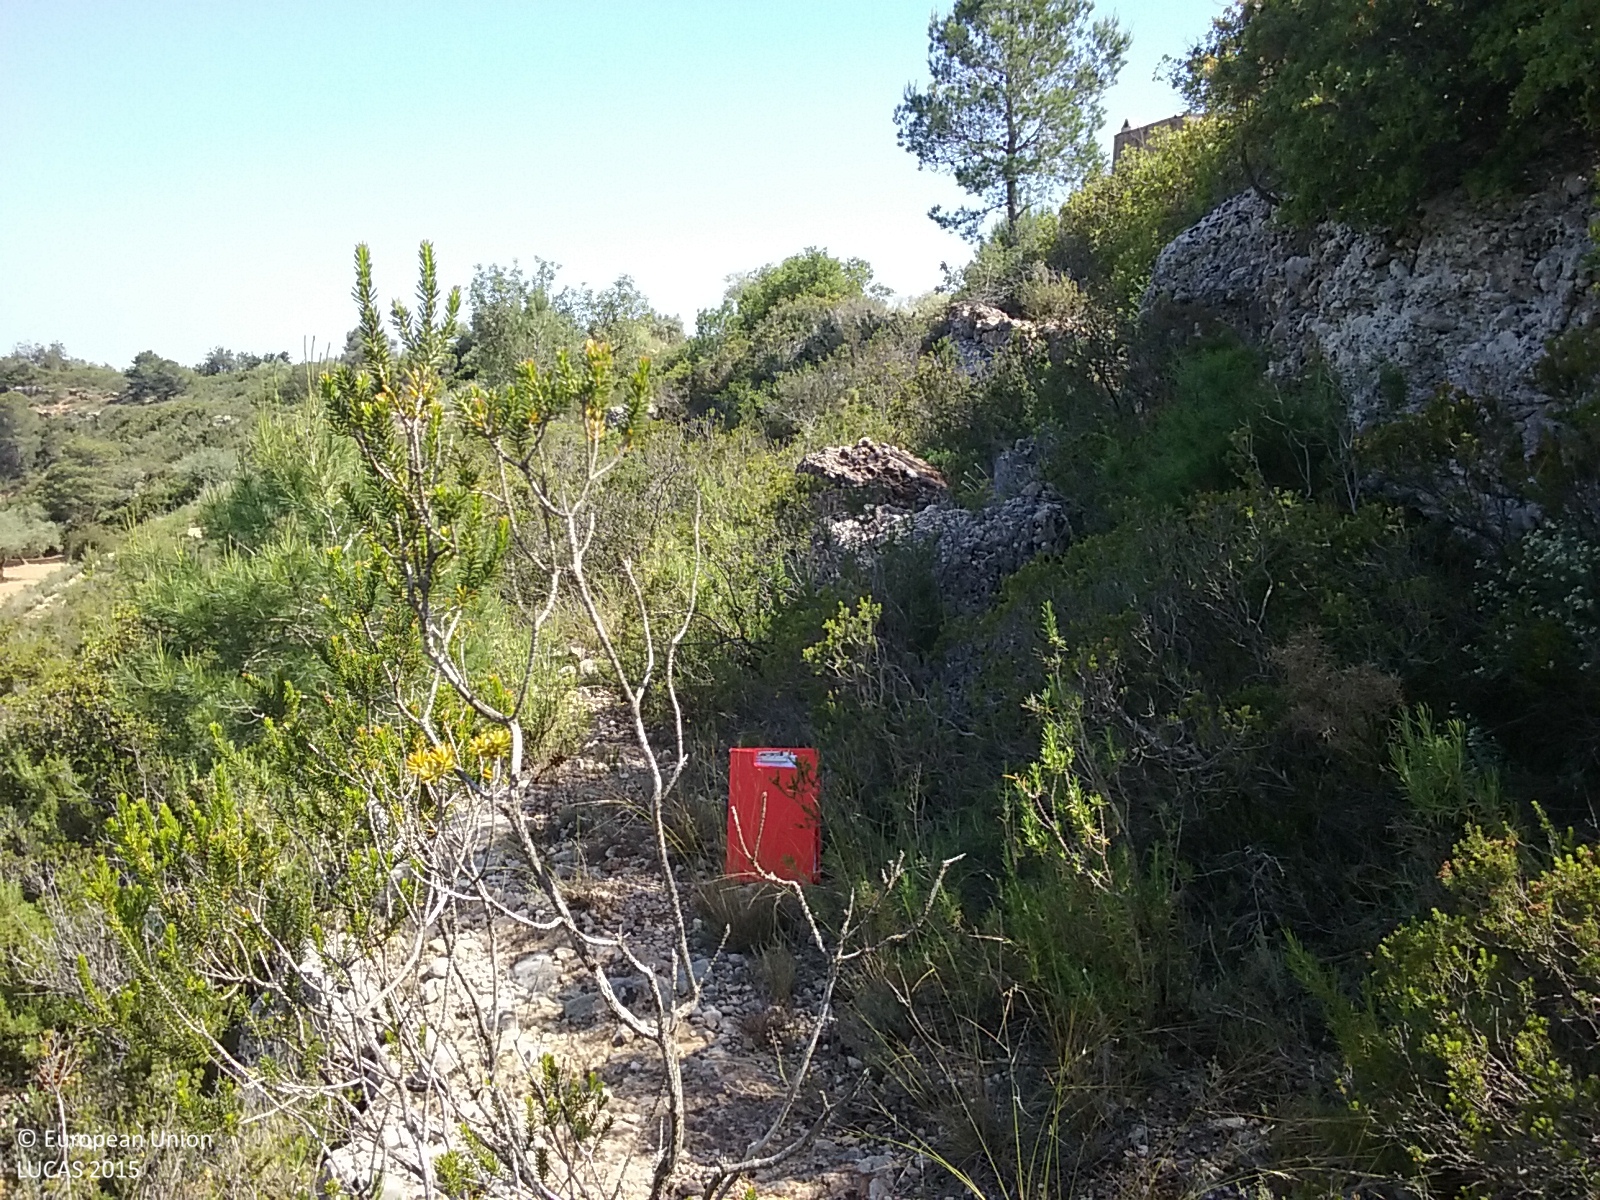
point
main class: Shrubland
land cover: Shrubland with sparse tree cover
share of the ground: > 75 %
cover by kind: shrubs 85 %, coniferous forest trees 5 %
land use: Semi-natural and natural areas not in use
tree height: > 5 m
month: May
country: ES
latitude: 40.5862
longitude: 0.2948
